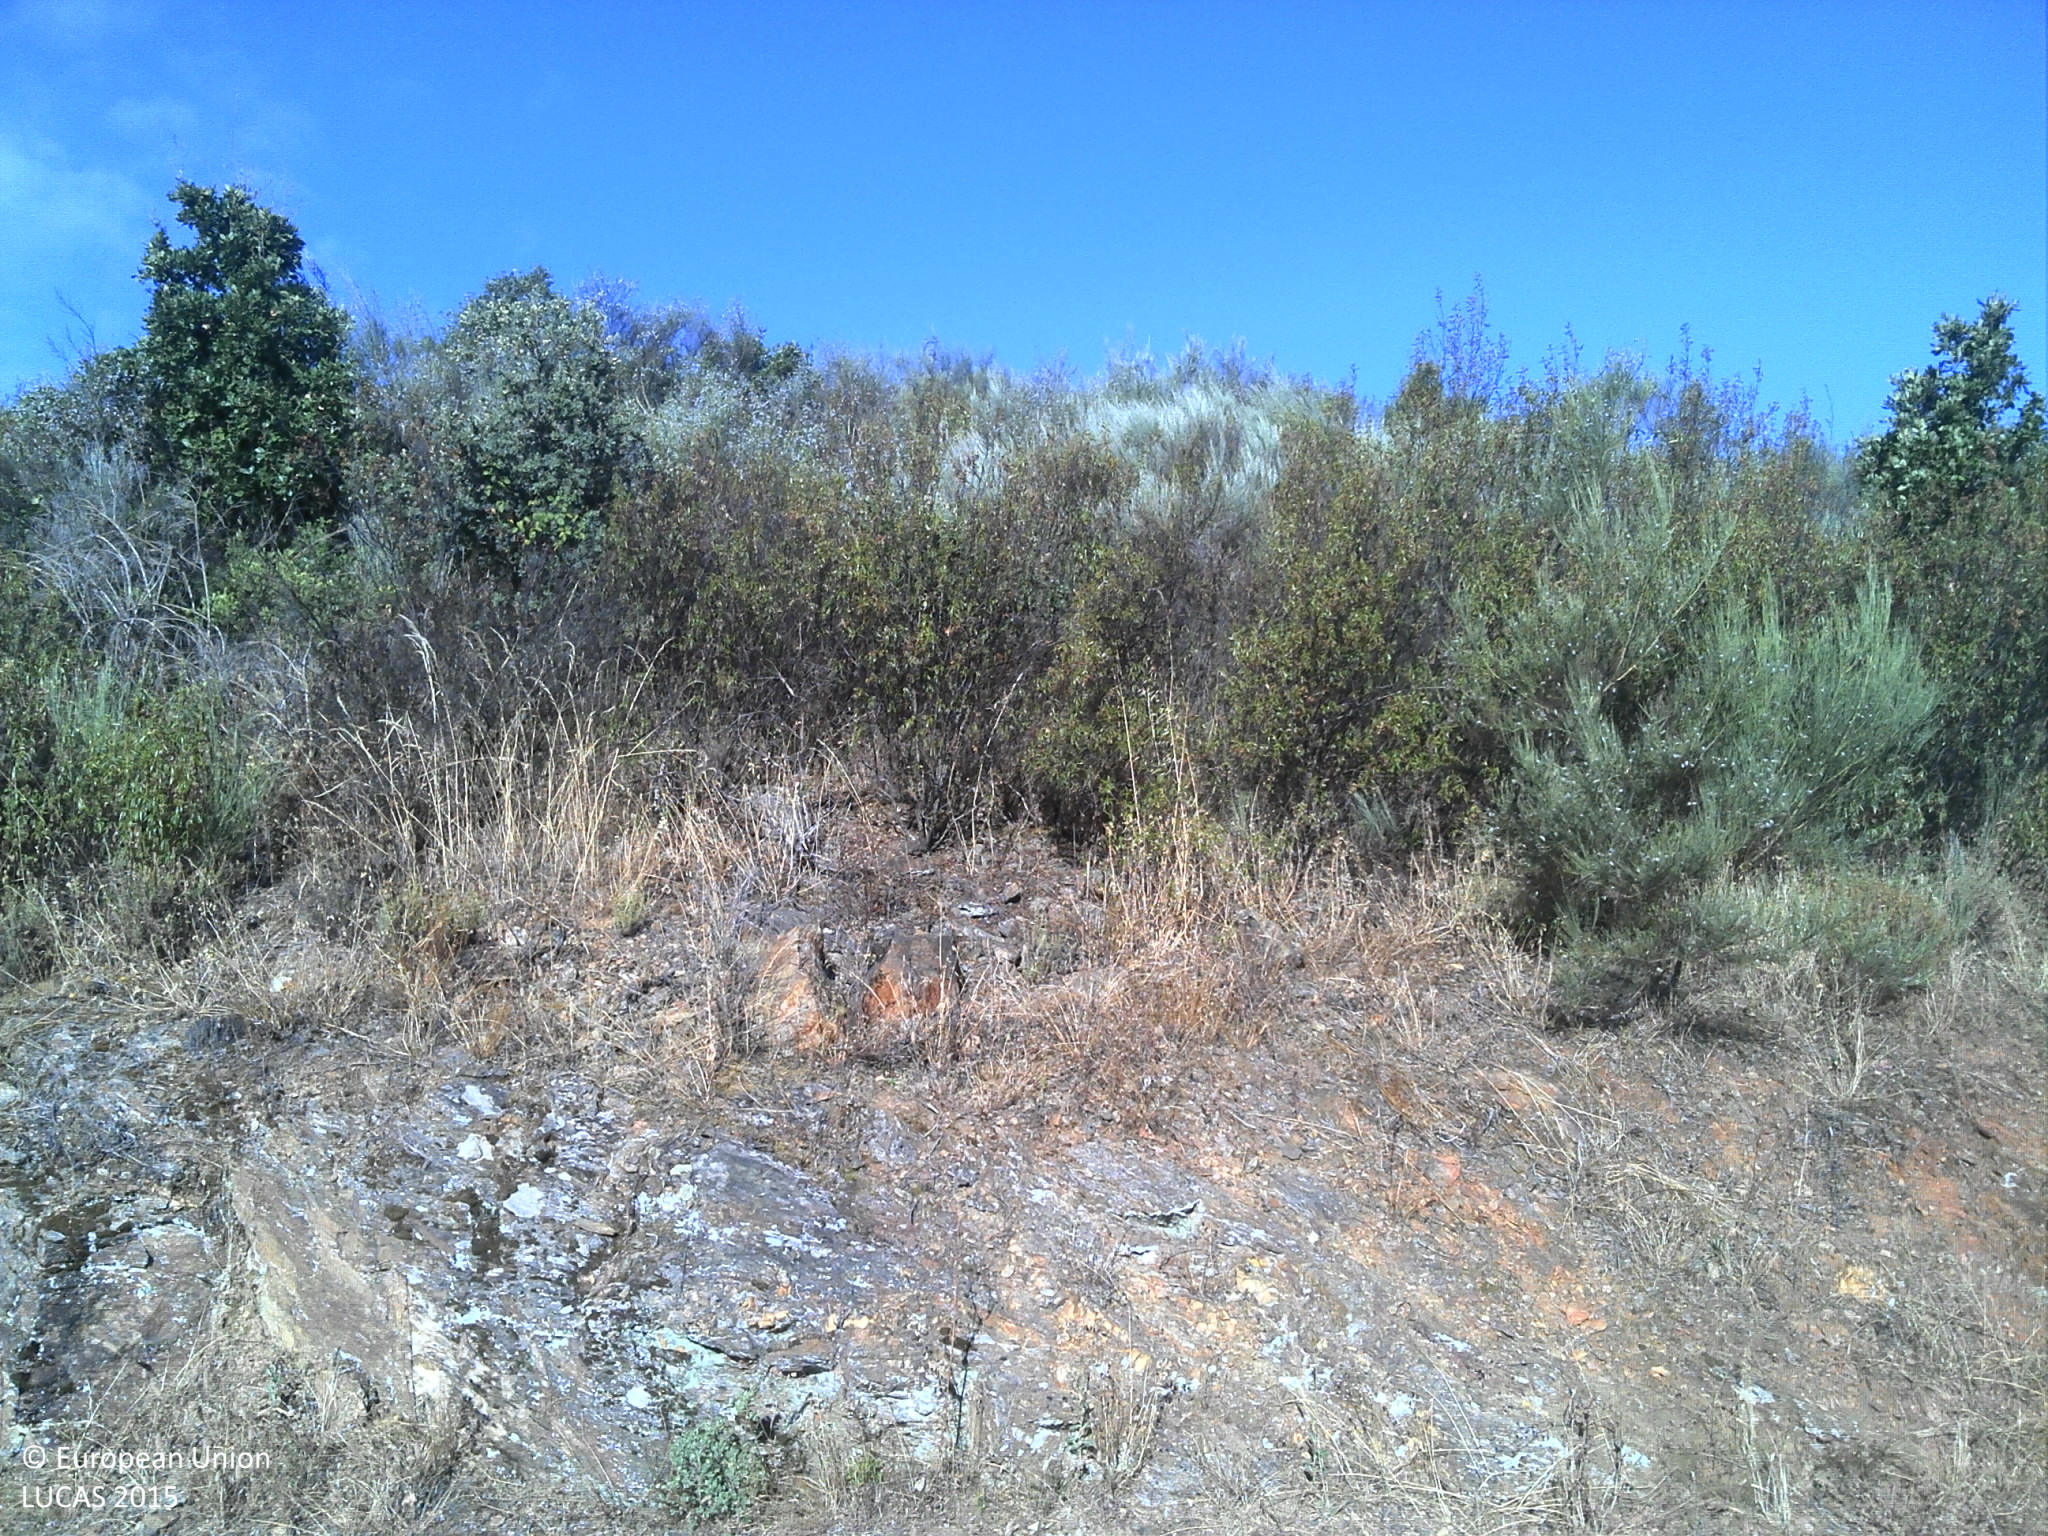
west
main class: Shrubland
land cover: Shrubland with sparse tree cover
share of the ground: > 75 %
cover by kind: shrubs 95 %, broadleaved forest trees 5 %
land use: Semi-natural and natural areas not in use
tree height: > 5 m
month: July
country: PT
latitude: 41.4098
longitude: -7.0907
